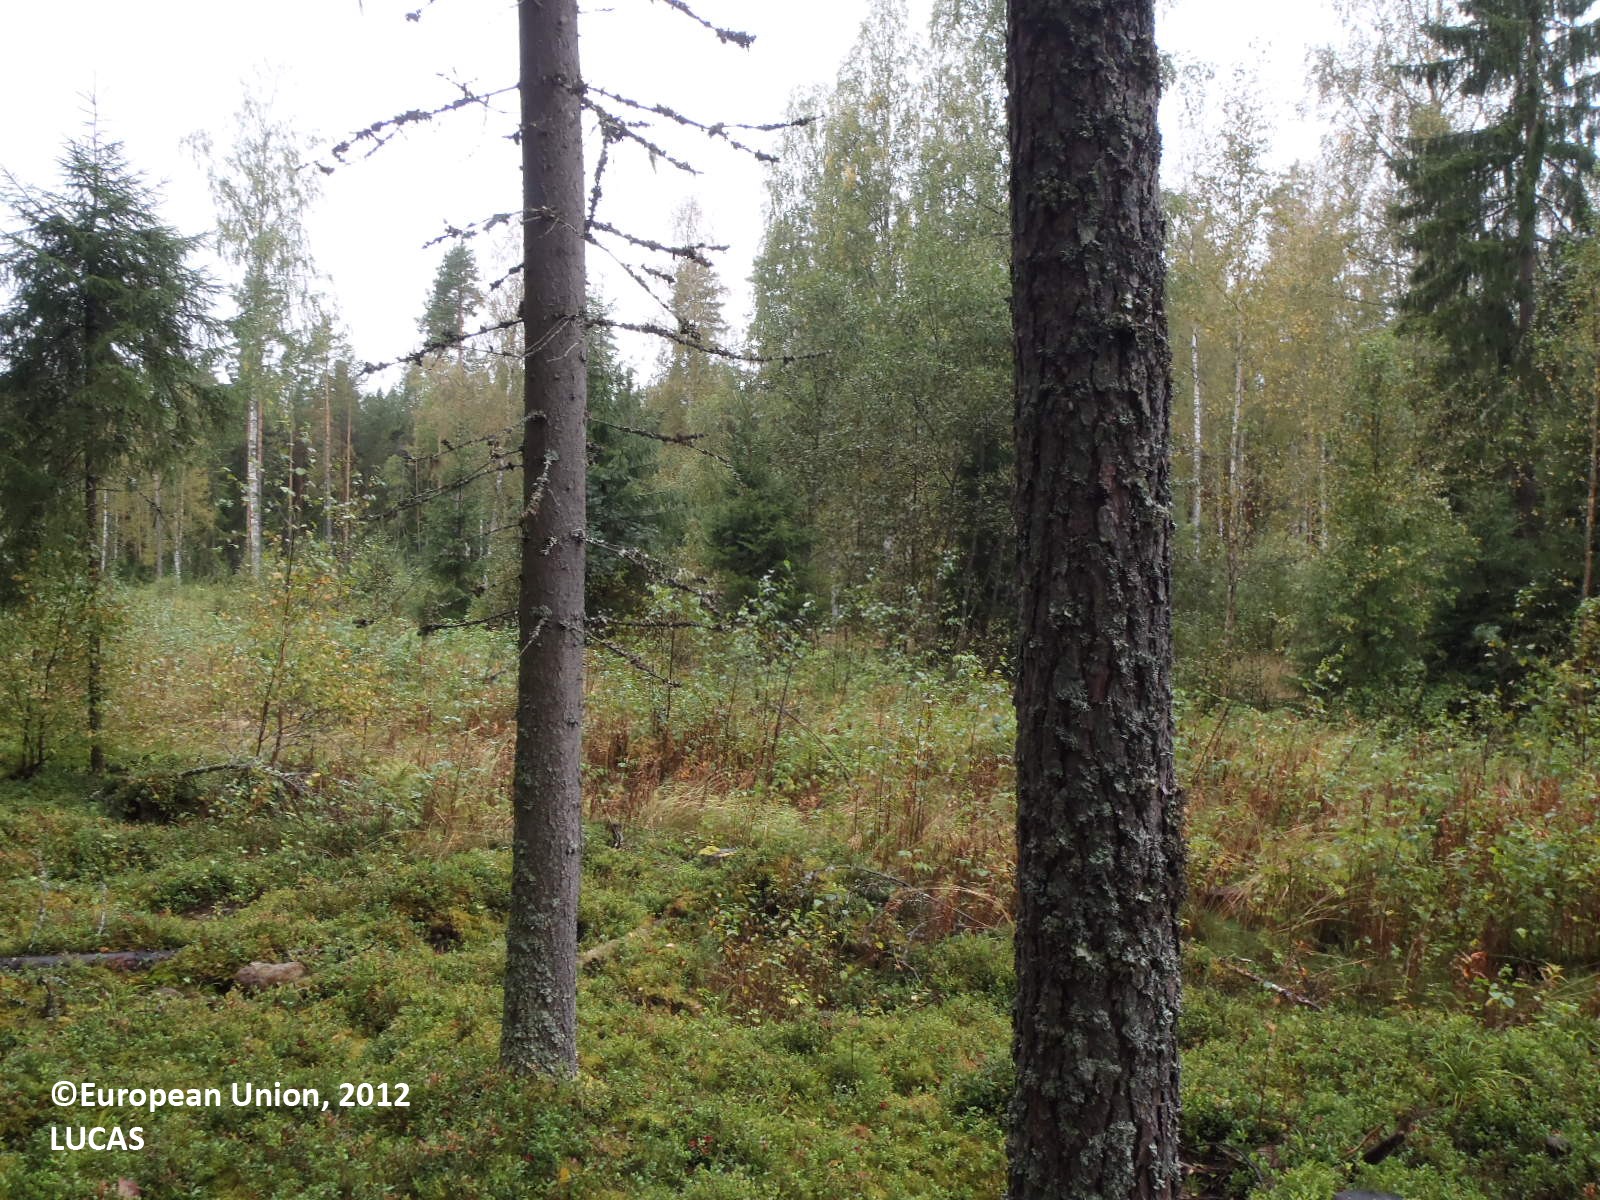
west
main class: Woodland
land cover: Spruce dominated coniferous woodland
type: boreal forest
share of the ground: > 75 %
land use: Forestry
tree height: > 5 m
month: September
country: FI
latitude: 61.5519
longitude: 22.5782
